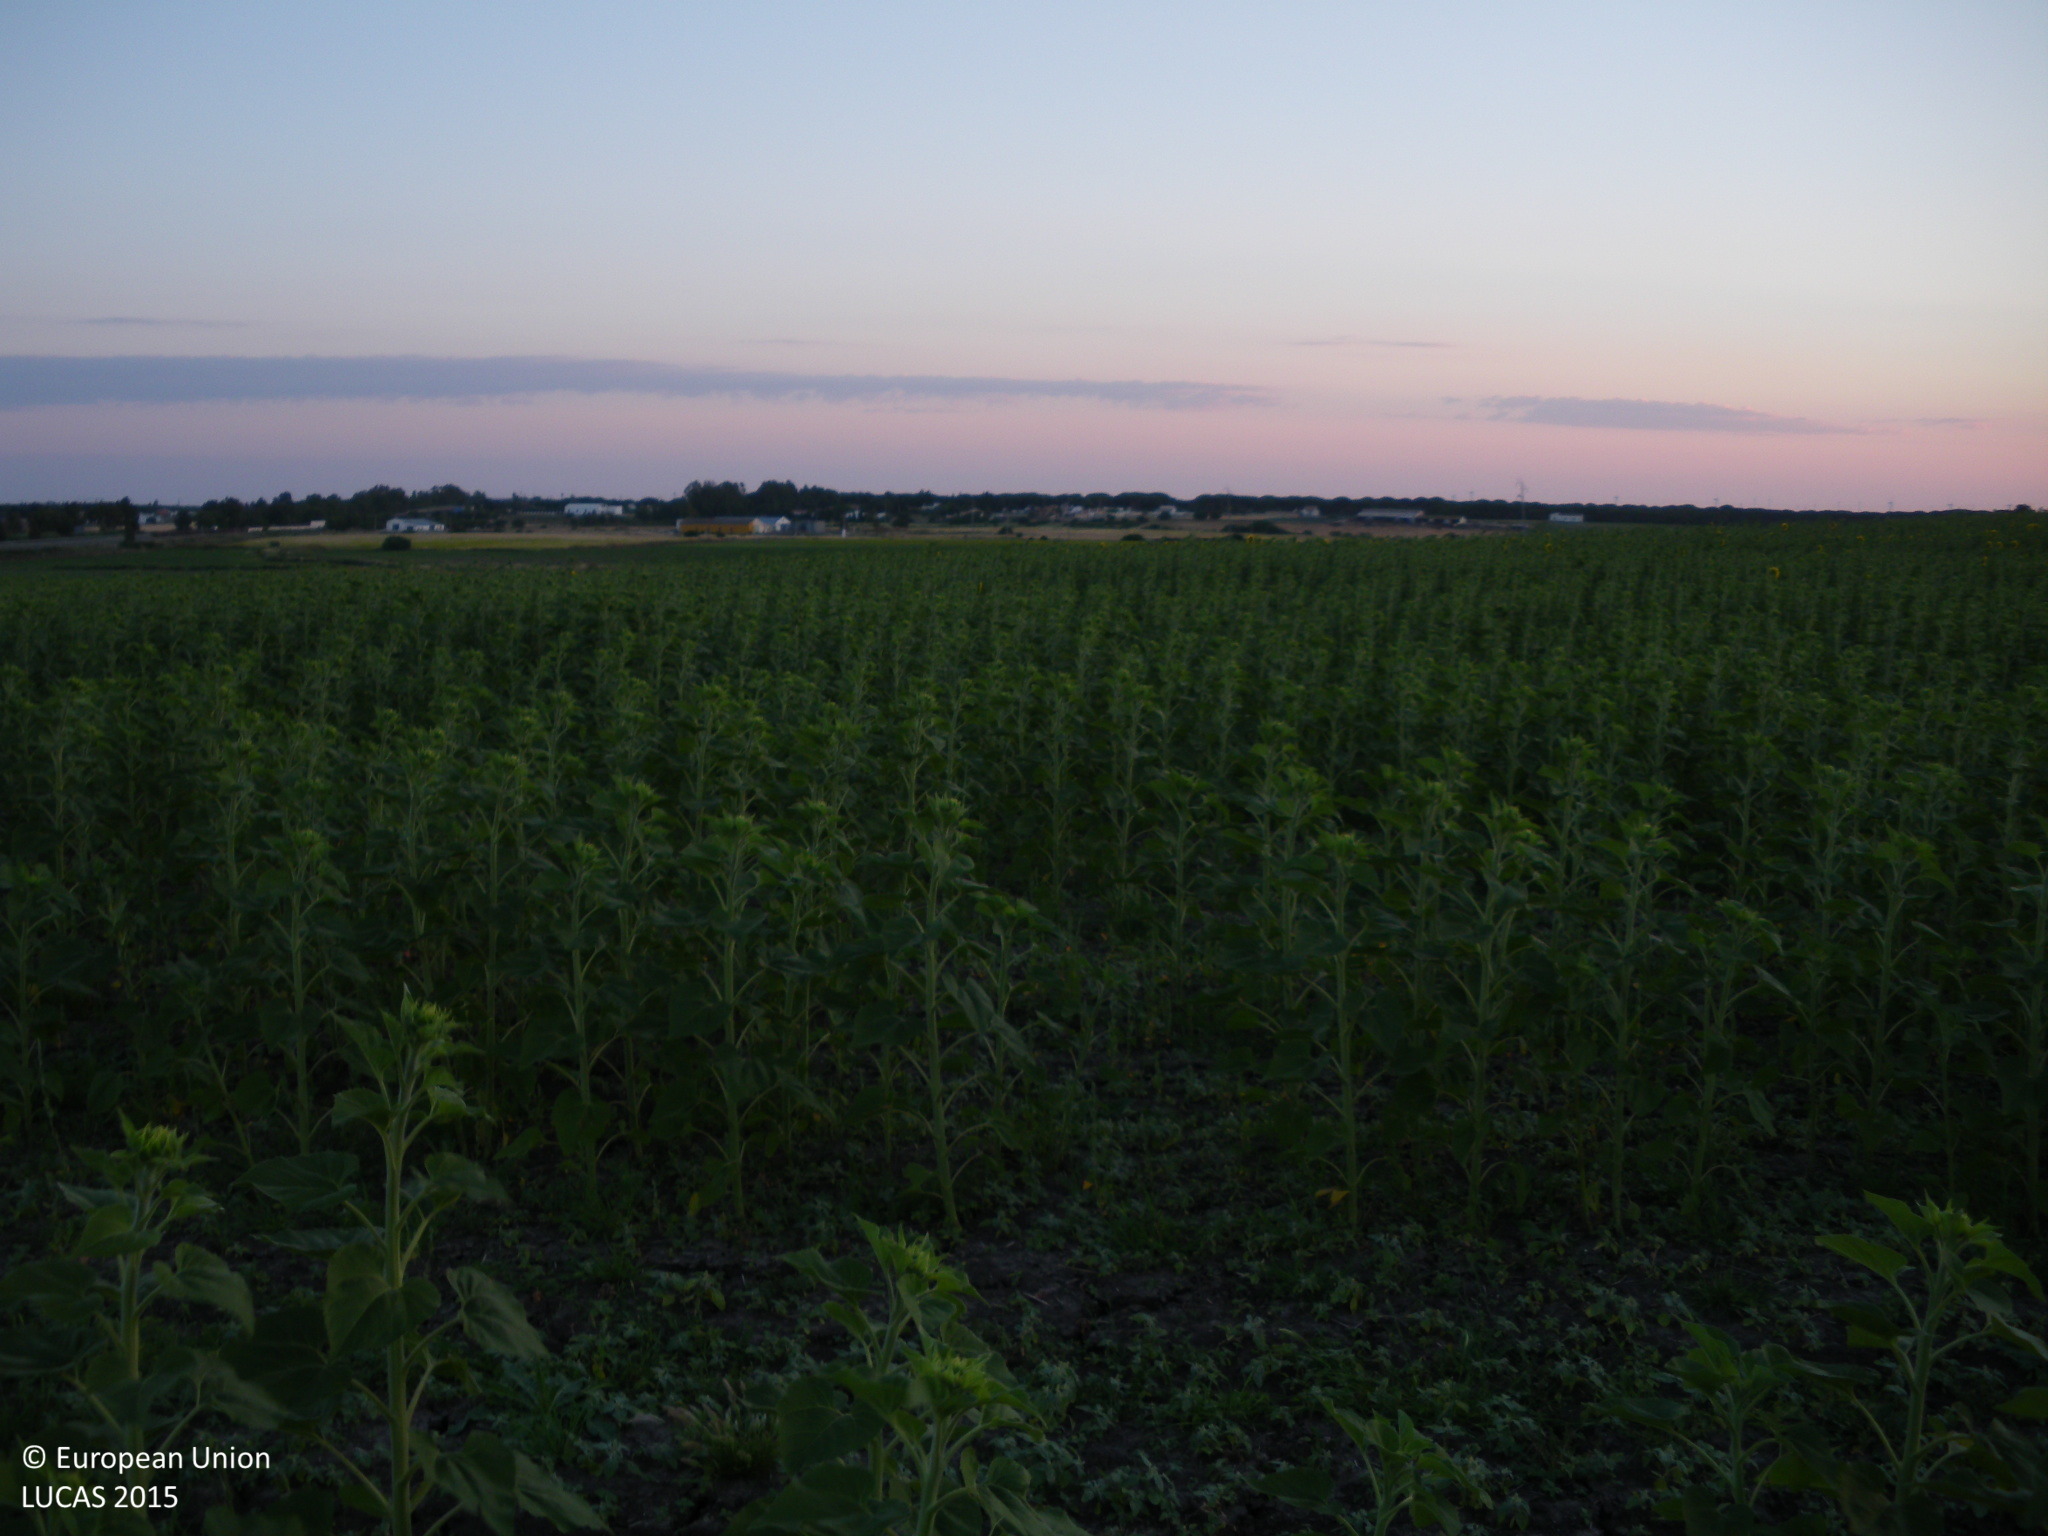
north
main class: Cropland
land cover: Sunflower
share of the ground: 25 - 50 %
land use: Agriculture (excluding fallow land and kitchen gardens)
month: May
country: ES
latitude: 36.3642
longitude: -6.1097
